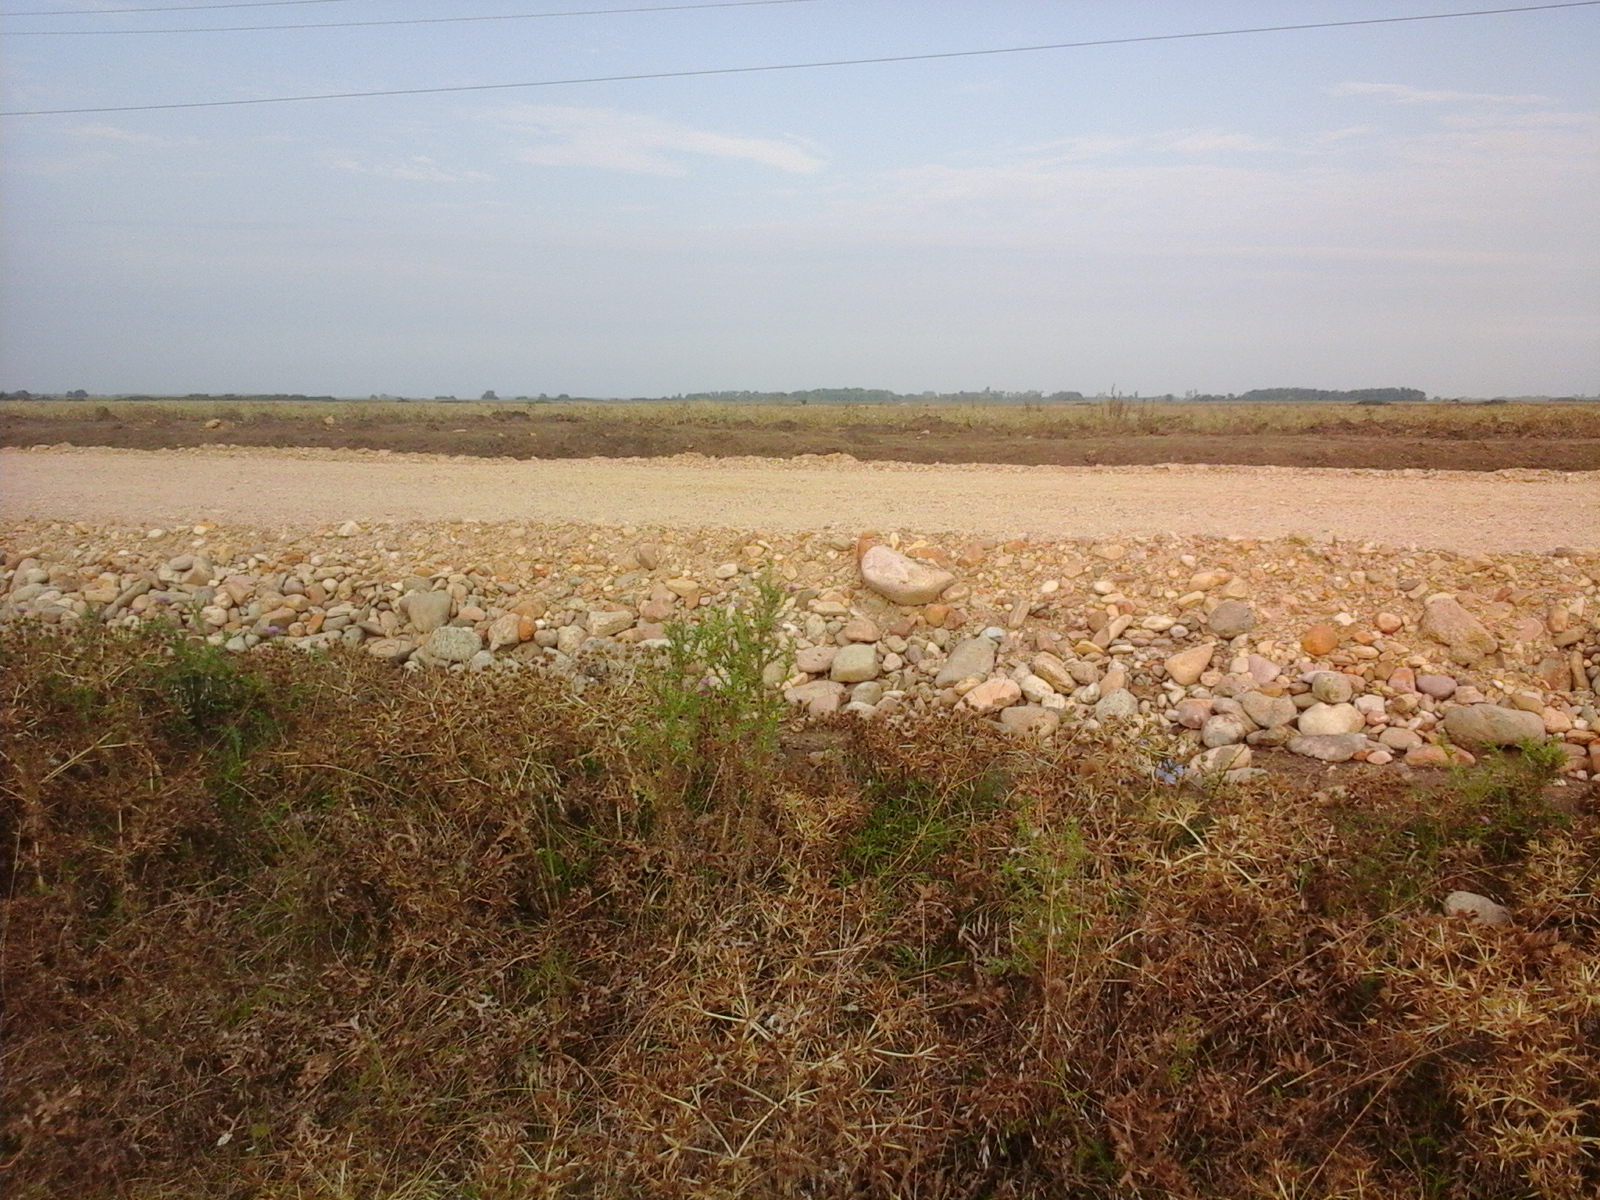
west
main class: Grassland
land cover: Grassland without tree/shrub cover
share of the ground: > 75 %
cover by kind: herbaceous plants 100 %
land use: Agriculture (excluding fallow land and kitchen gardens)
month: August
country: RO
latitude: 46.7067
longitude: 21.5365
